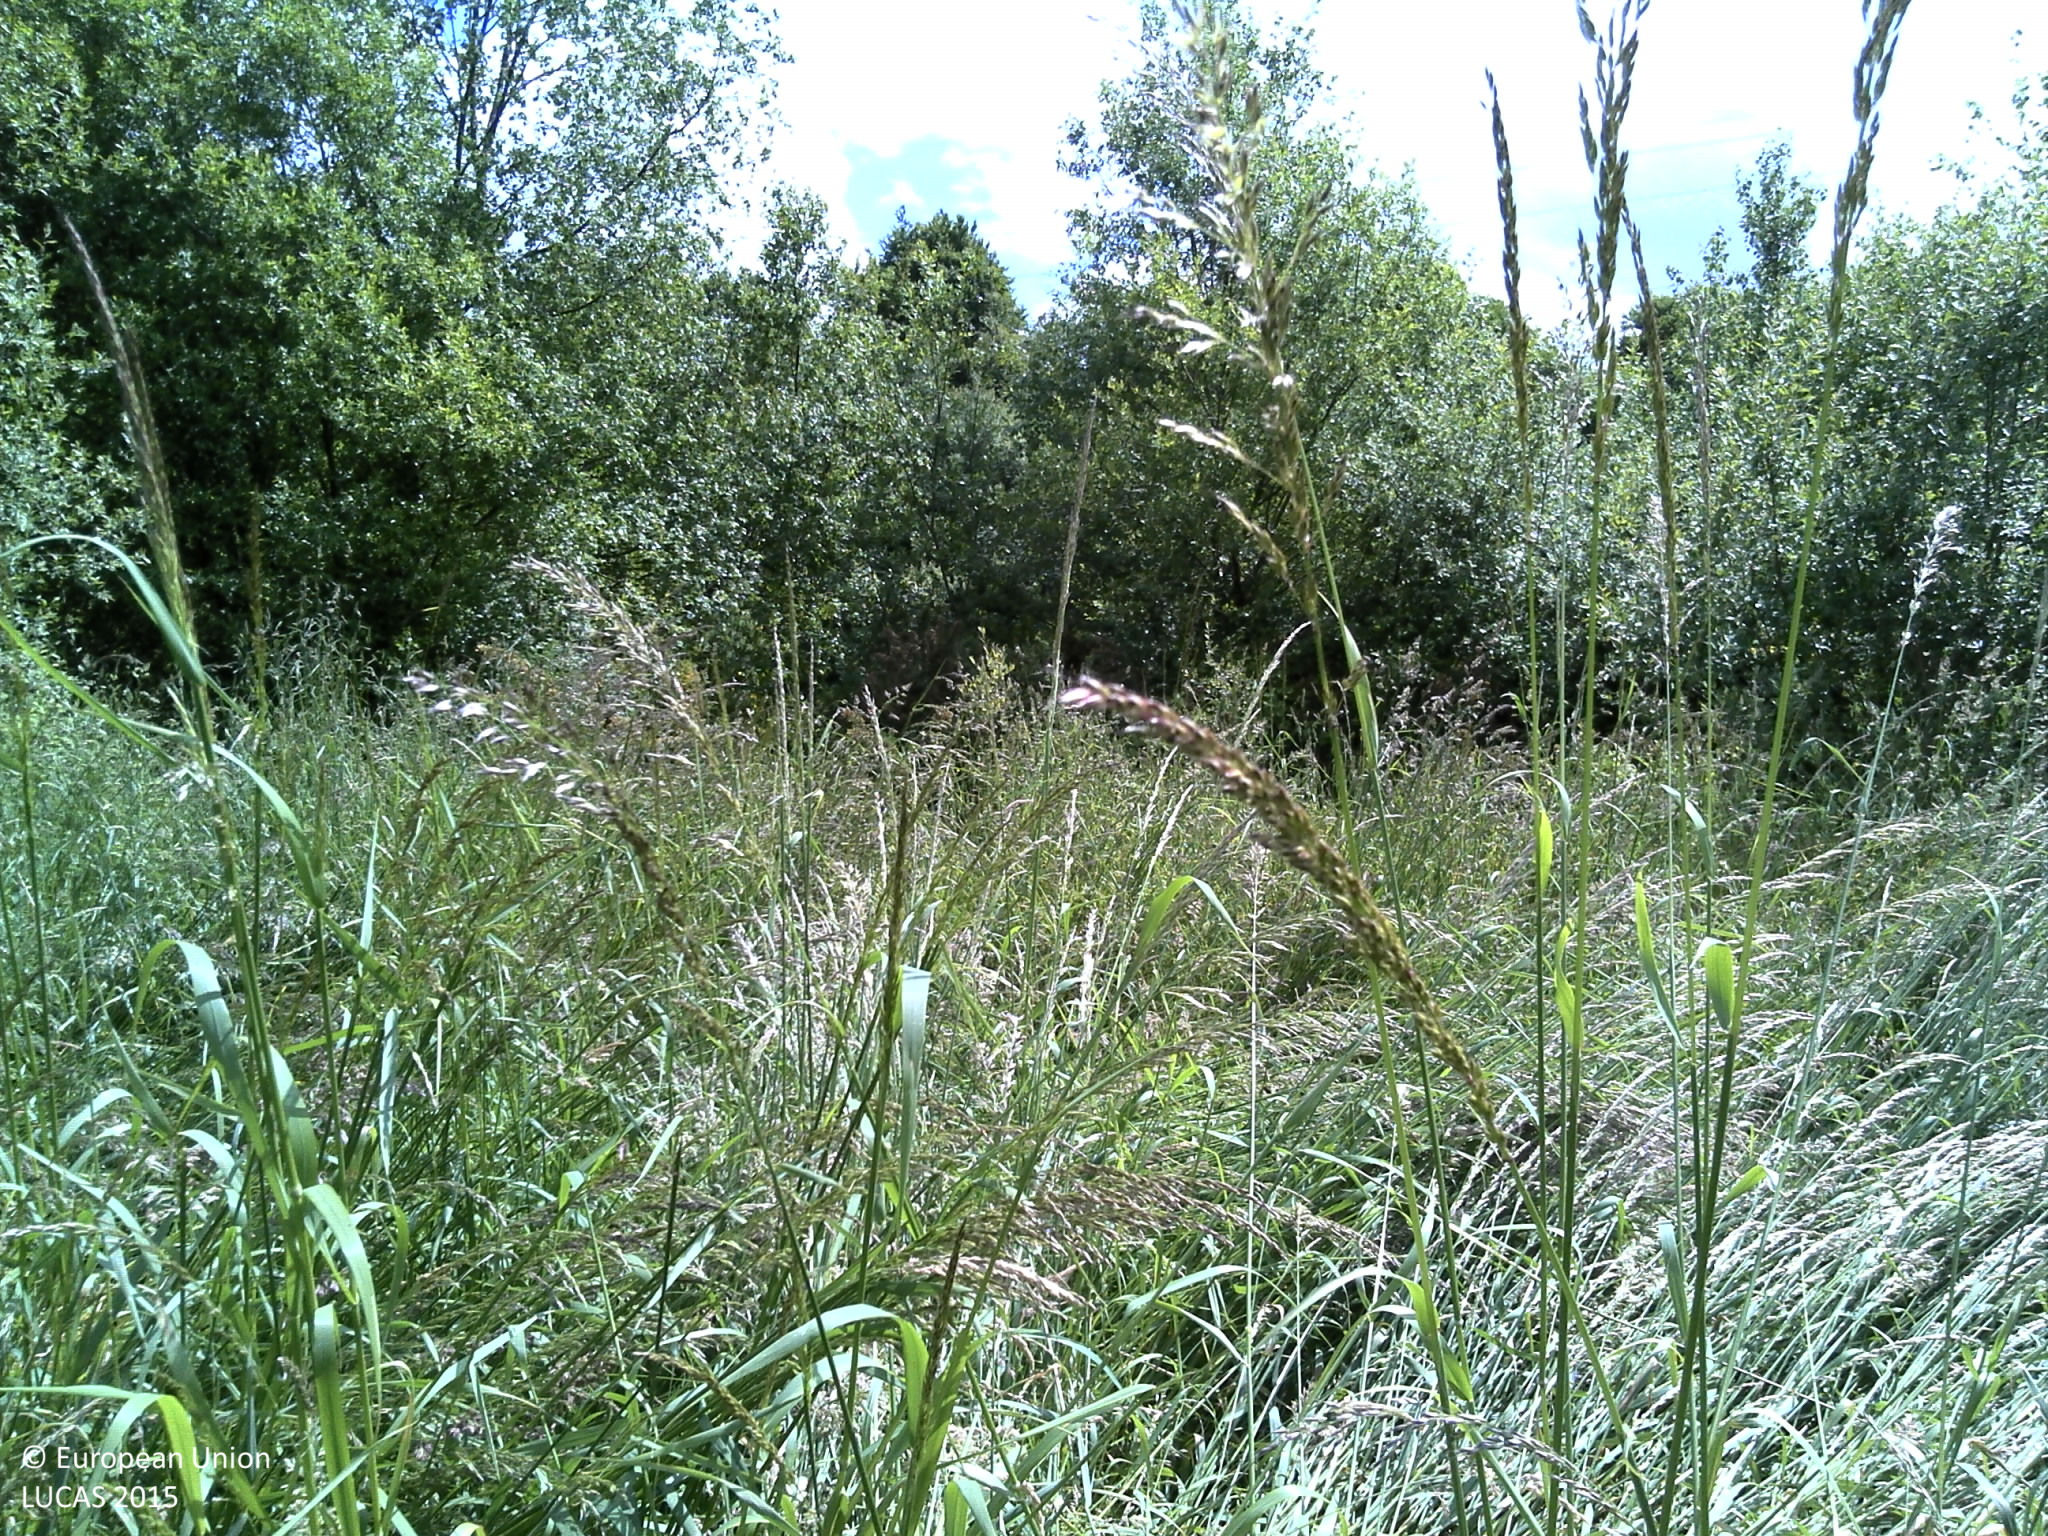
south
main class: Grassland
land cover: Grassland without tree/shrub cover
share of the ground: > 75 %
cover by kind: herbaceous plants 100 %
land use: Agriculture (excluding fallow land and kitchen gardens)
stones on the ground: < 10 %
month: June
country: FR
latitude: 47.9465
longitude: -3.5599
